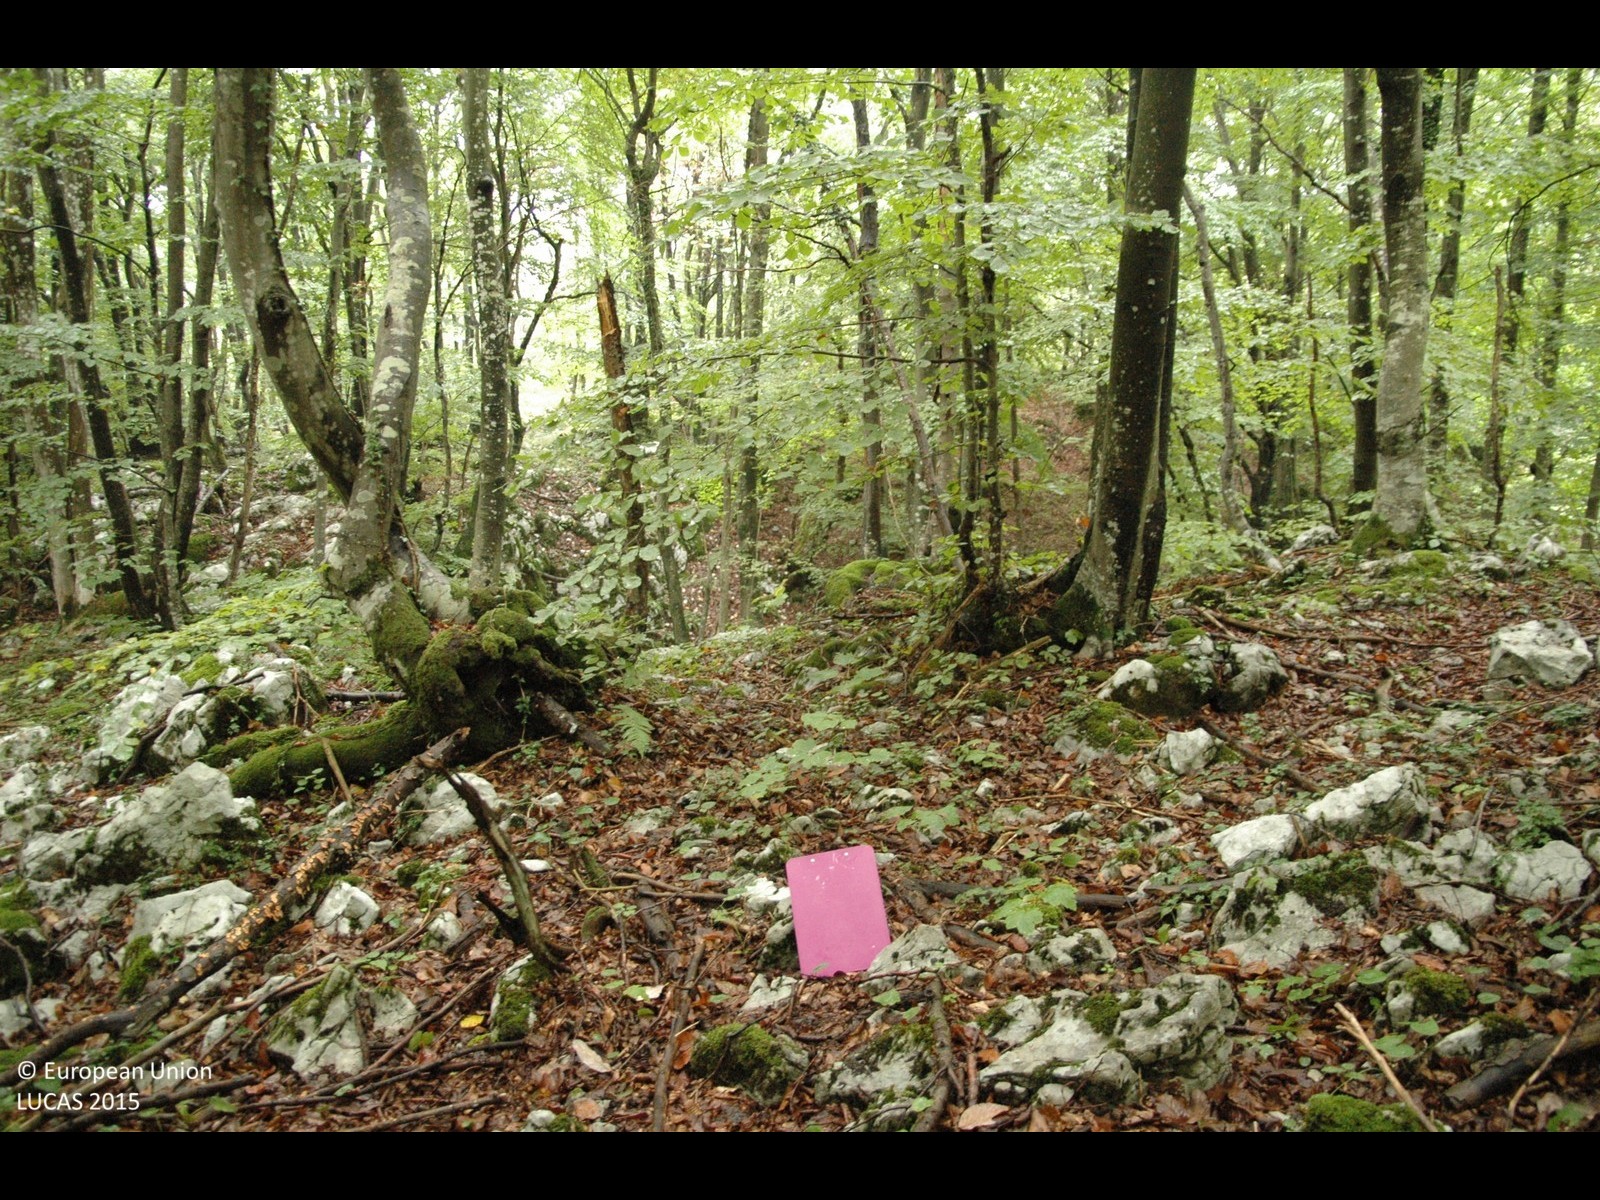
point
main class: Woodland
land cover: Broadleaved woodland
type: beech forest
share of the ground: > 75 %
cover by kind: broadleaved forest trees 100 %
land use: Forestry
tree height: > 5 m
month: October
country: HR
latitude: 45.1392
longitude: 15.2469
